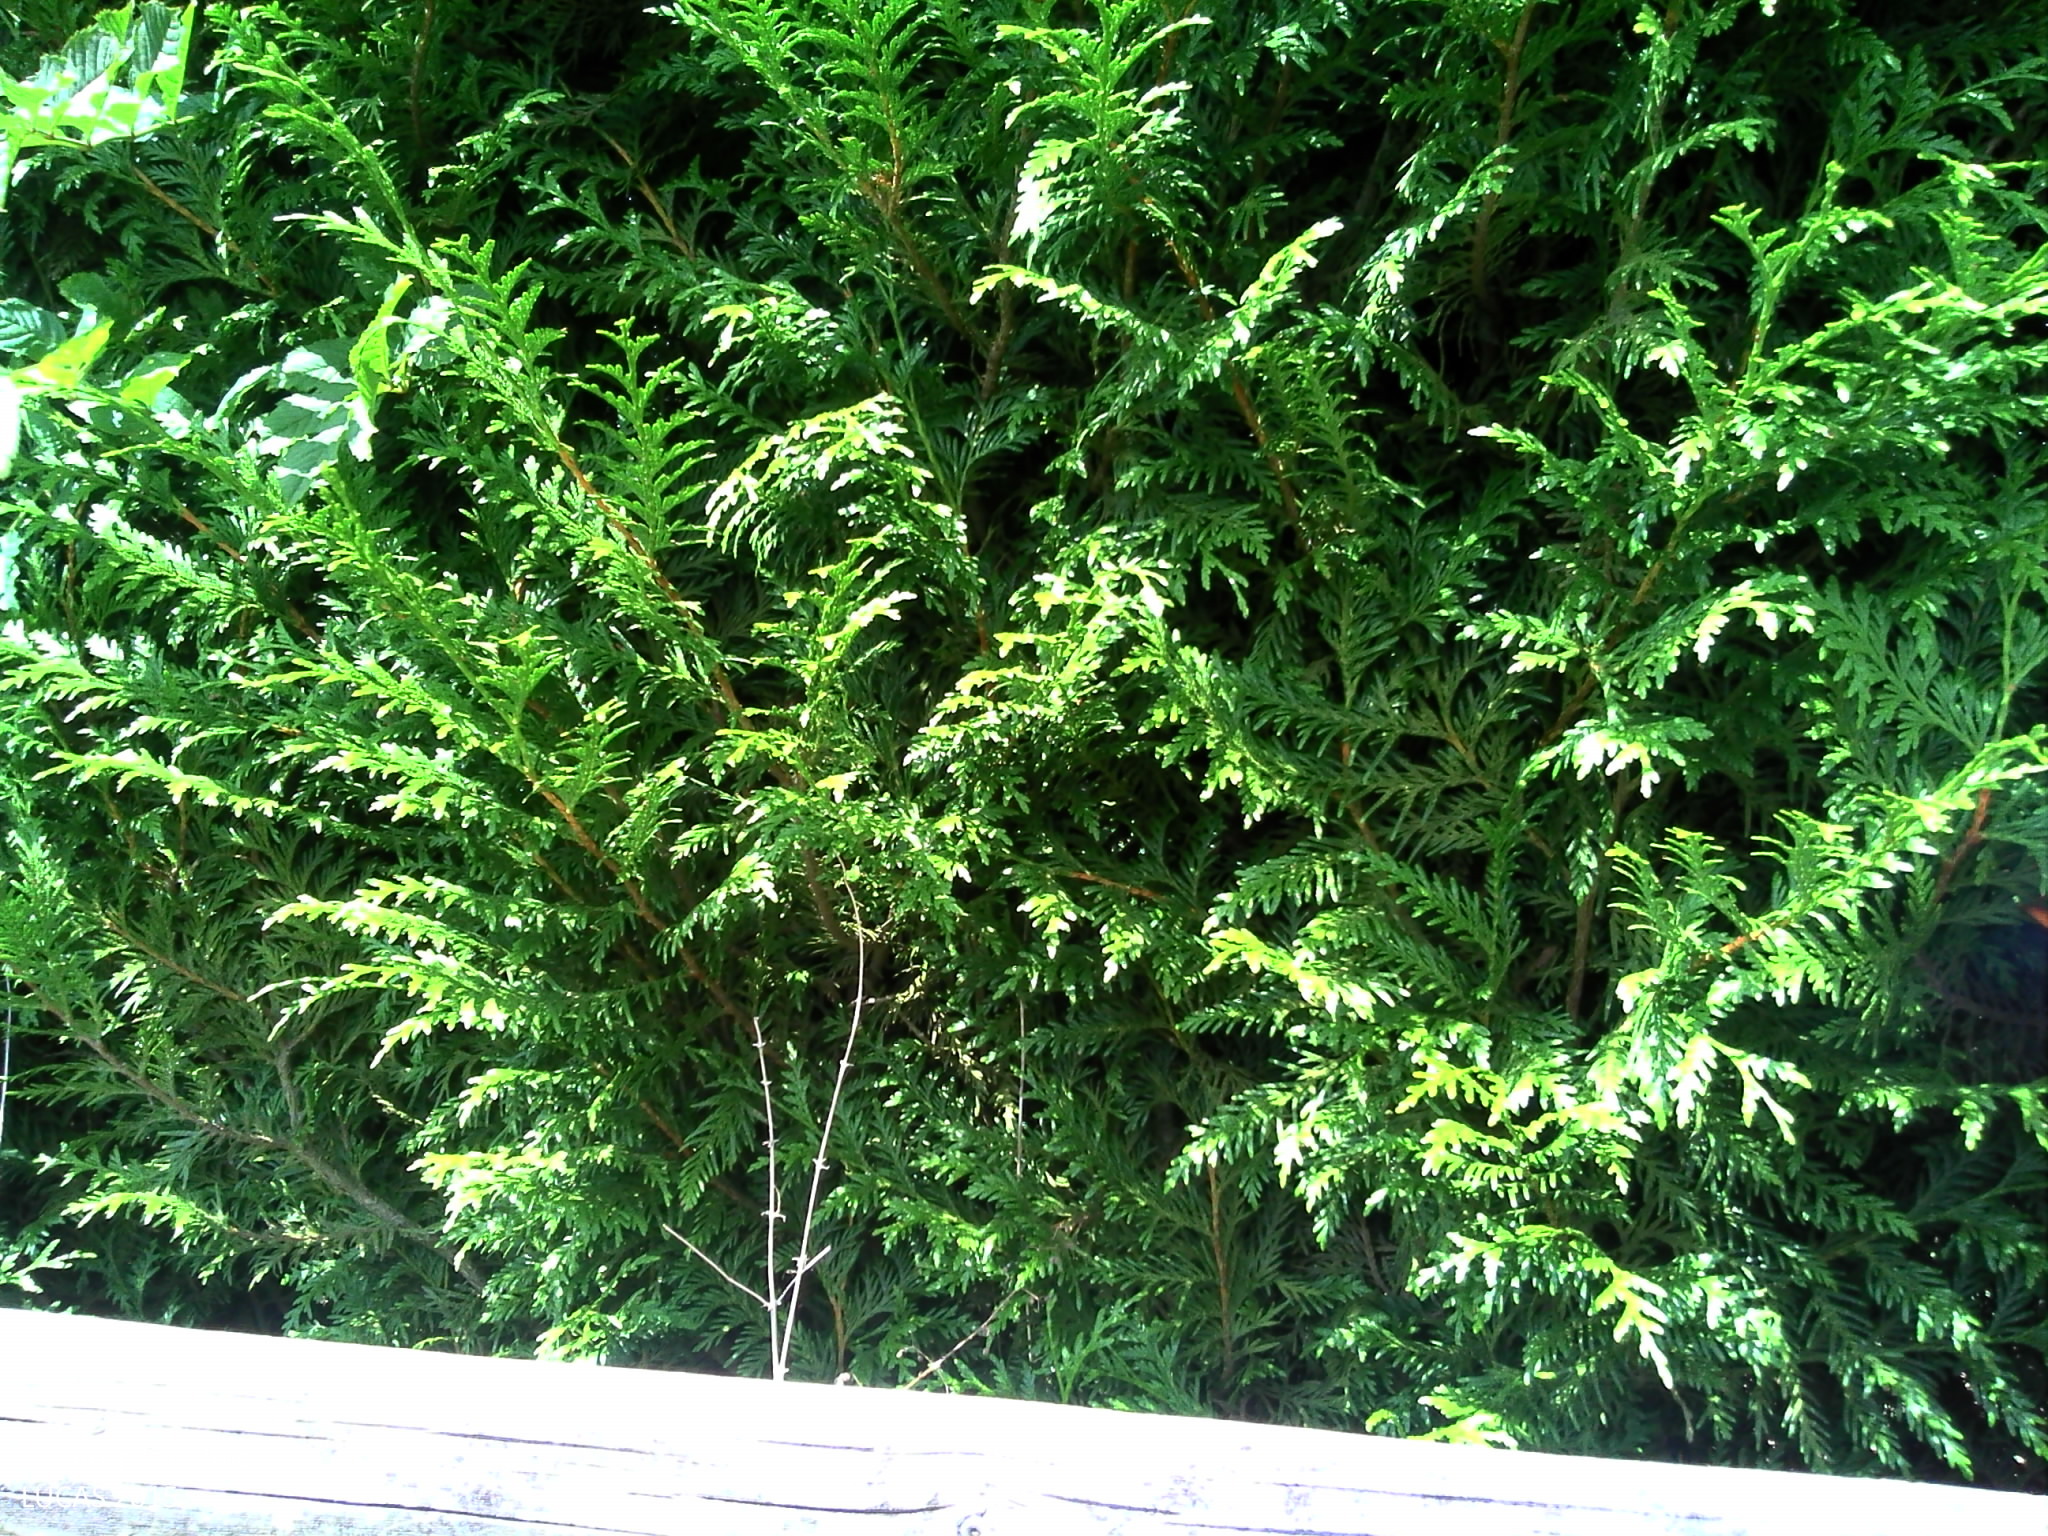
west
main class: Grassland
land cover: Grassland without tree/shrub cover
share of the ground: > 75 %
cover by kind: herbaceous plants 100 %
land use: Residential
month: July
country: FR
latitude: 48.6246
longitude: 0.4641
